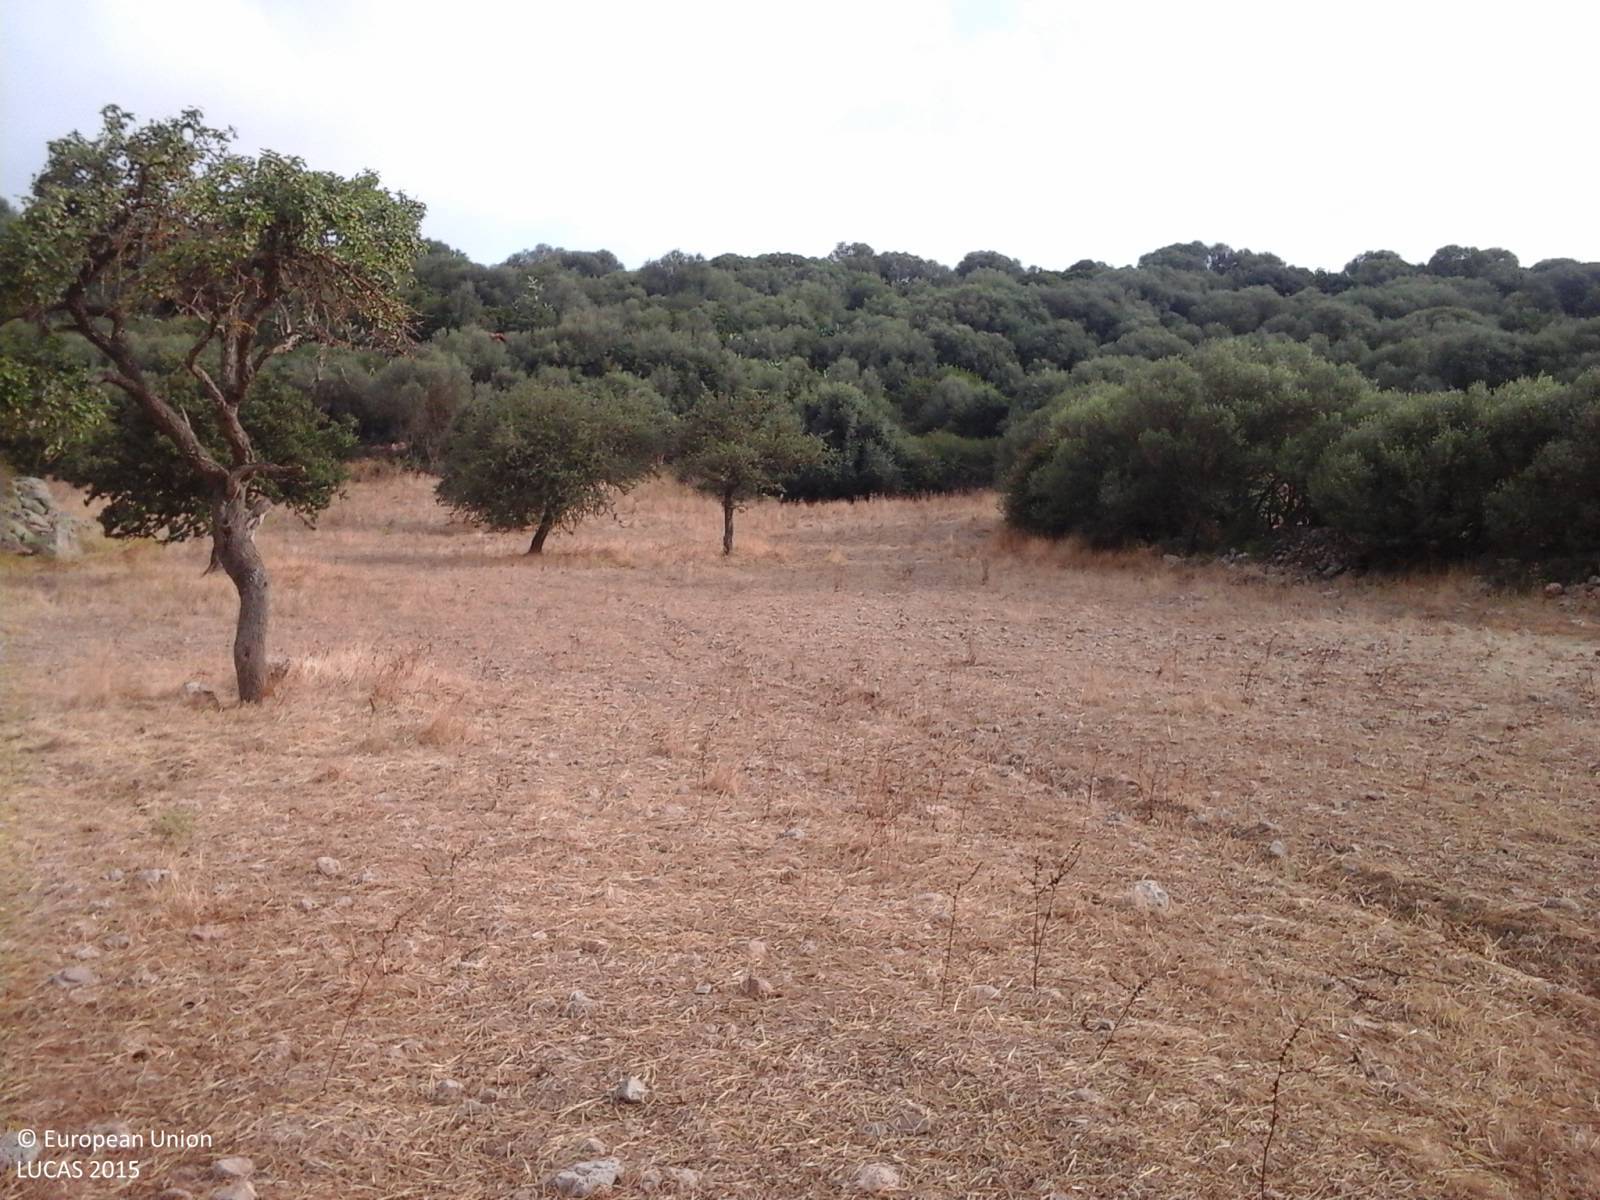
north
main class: Grassland
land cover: Grassland without tree/shrub cover
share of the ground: < 10 %
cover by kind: herbaceous plants 100 %
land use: Agriculture (excluding fallow land and kitchen gardens)
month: July
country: IT
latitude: 40.6411
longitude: 8.8822
